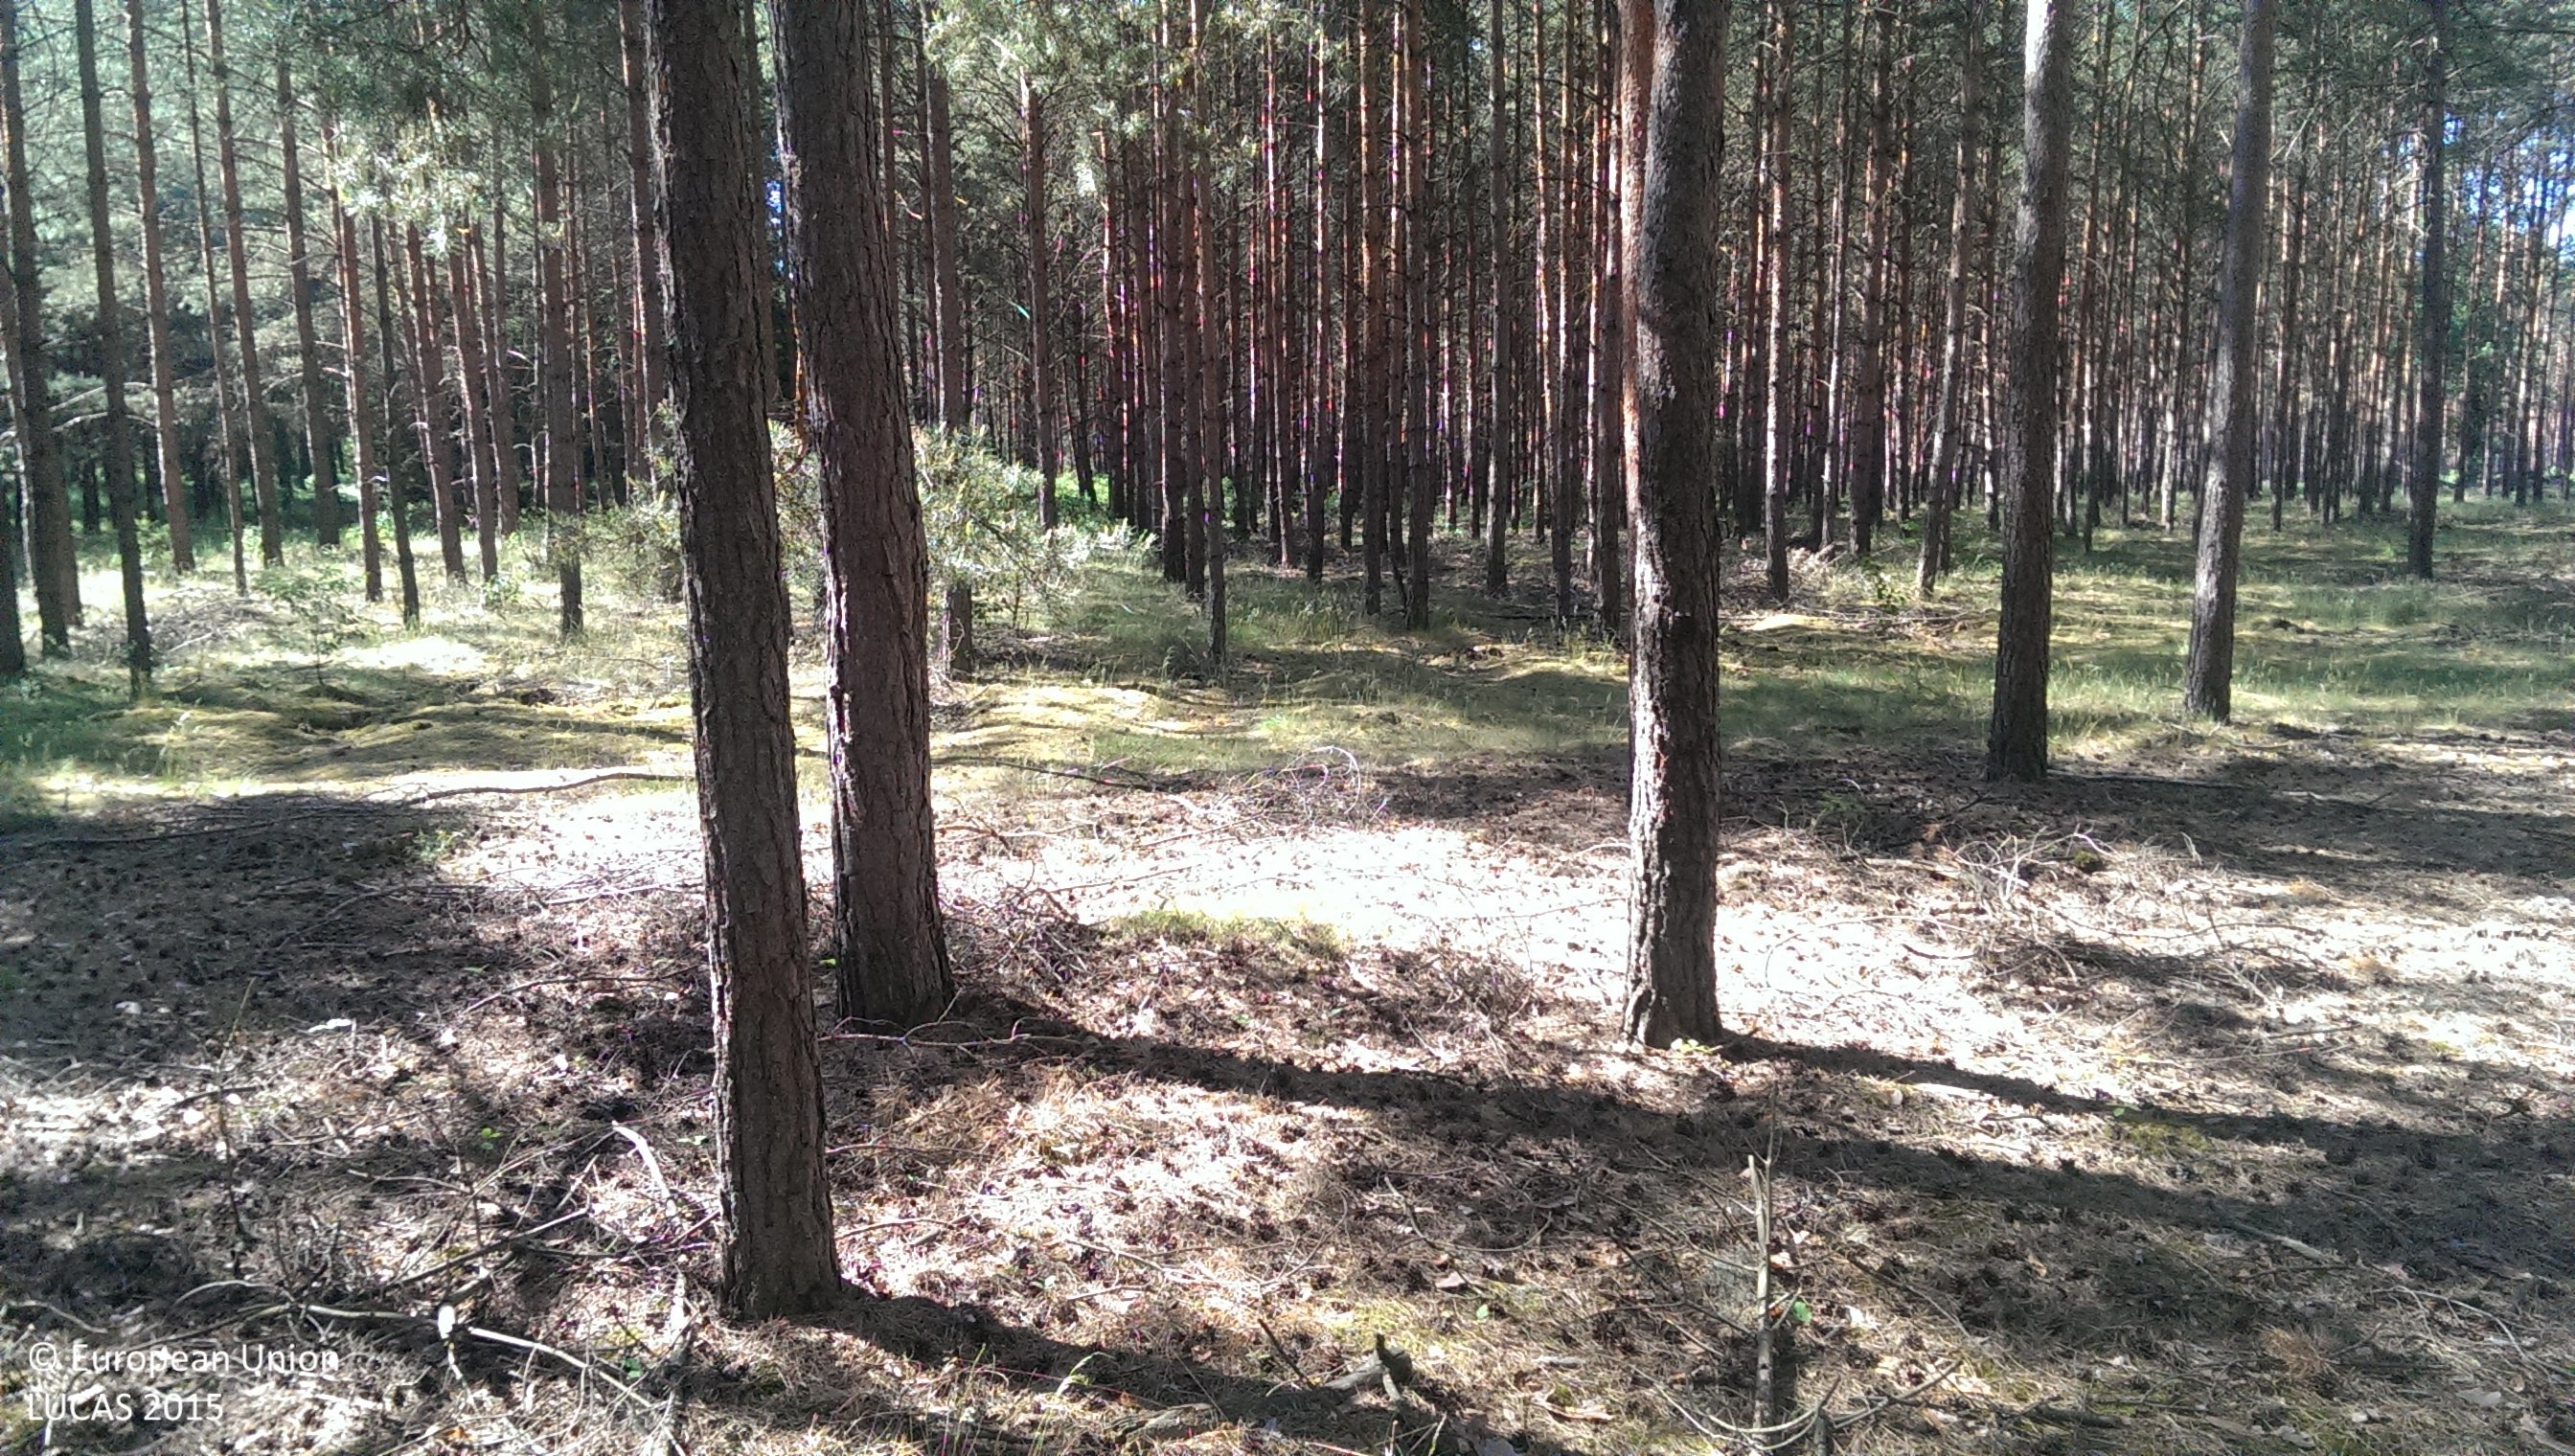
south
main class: Woodland
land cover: Pine dominated coniferous woodland
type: hemiboreal forest and nemoral coniferous forest and mixed broadleaved-coniferous forest
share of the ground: 50 - 75 %
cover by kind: coniferous forest trees 65 %, lichens and mosses 15 %, unconsolidated bare surface 15 %, broadleaved forest trees 5 %
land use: Forestry
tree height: > 5 m
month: June
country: PL
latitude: 51.9977
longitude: 16.2259
